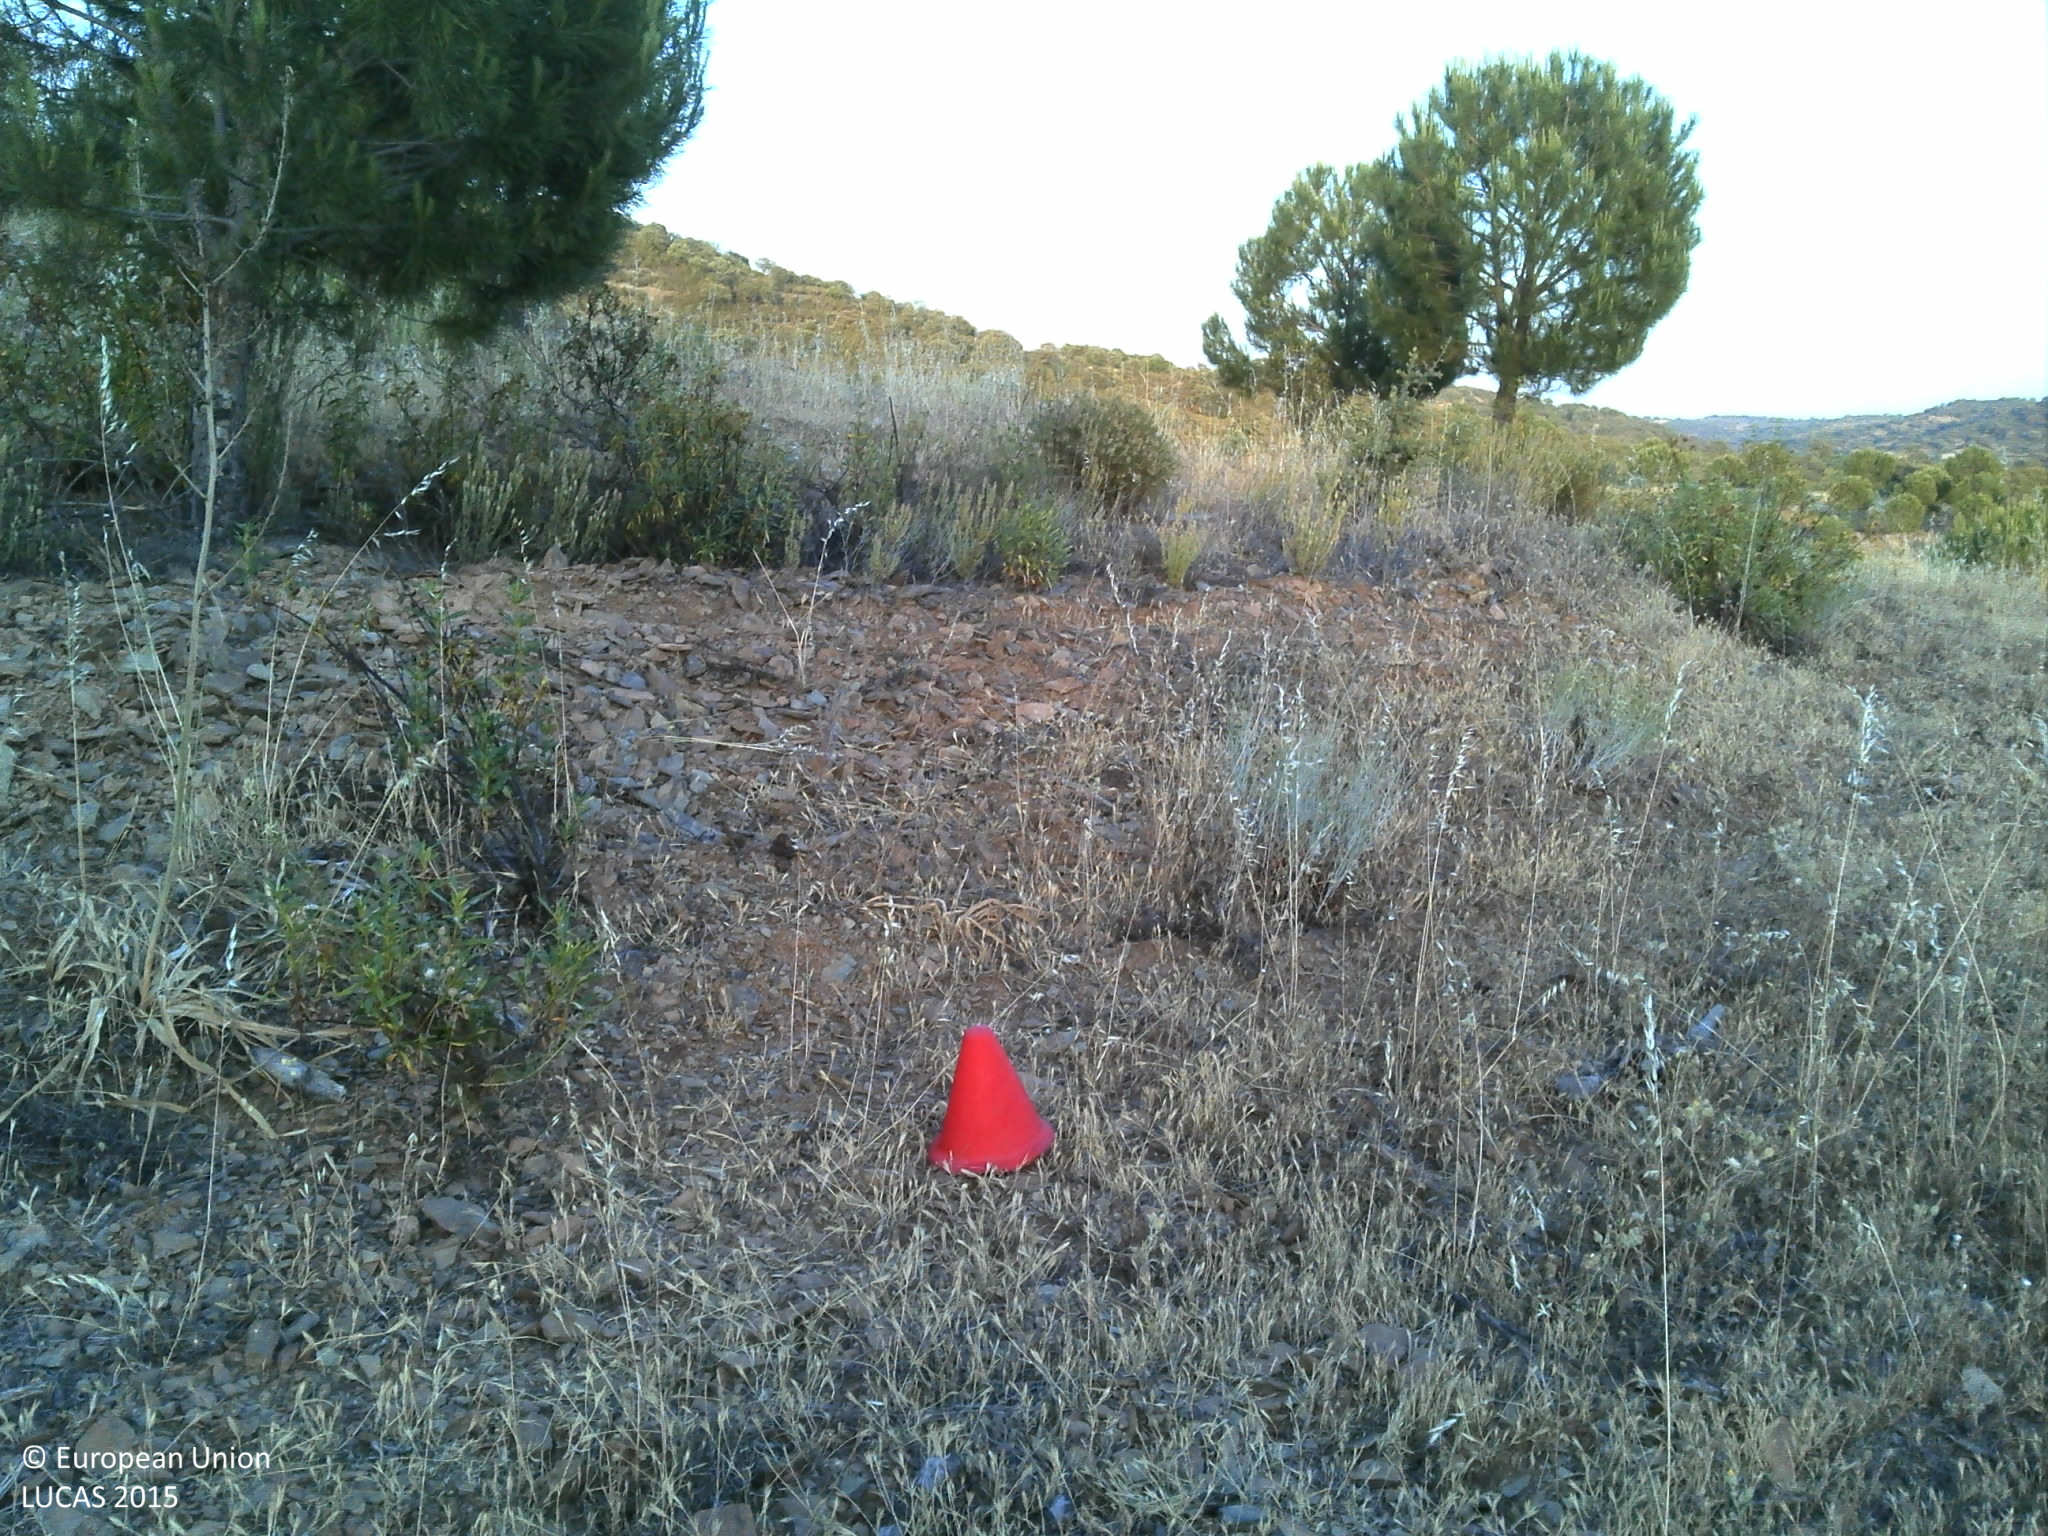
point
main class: Woodland
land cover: Pine dominated coniferous woodland
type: coniferous forest of the mediterranean region
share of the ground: 10 - 25 %
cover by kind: herbaceous plants 60 %, coniferous forest trees 25 %, consolidated bare surface 10 %, shrubs 5 %
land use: Forestry
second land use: Agriculture (excluding fallow land and kitchen gardens)
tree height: < 5 m
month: May
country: PT
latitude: 37.4863
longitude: -7.7592
